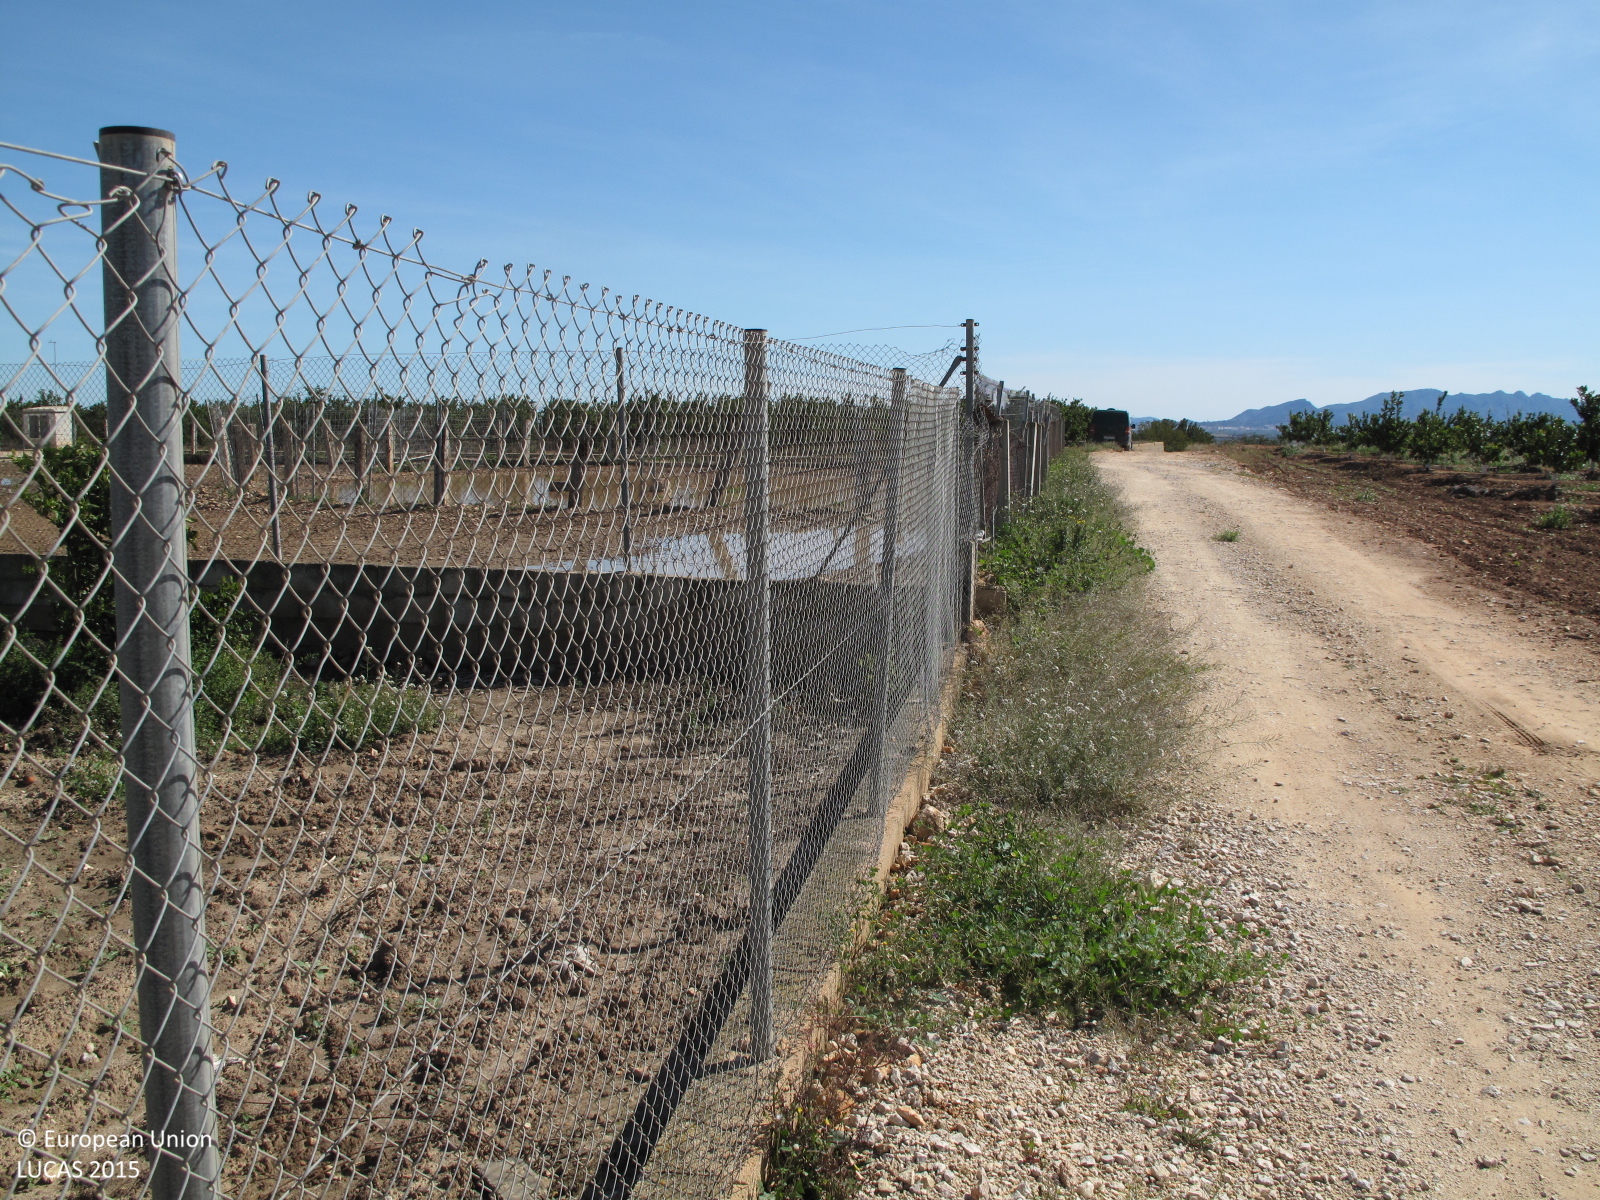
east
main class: Cropland
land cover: Oranges
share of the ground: 10 - 25 %
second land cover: Spontaneously vegetated surfaces
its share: 10 - 25 %
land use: Agriculture (excluding fallow land and kitchen gardens)
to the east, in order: Oranges; Spontaneously vegetated surfaces; Fences; Other bare soil; Fences; Inland fresh water bodies; Fences; Tracks; Dry stone walls; Oranges; Dry stone walls; Oranges; Dry stone walls; Oranges; Dry stone walls; Grassland with sparse tree/shrub cover; Tracks; Grassland with sparse tree/shrub cover; Dry stone walls; Olive groves
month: March
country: ES
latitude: 39.1462
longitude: -0.5818
